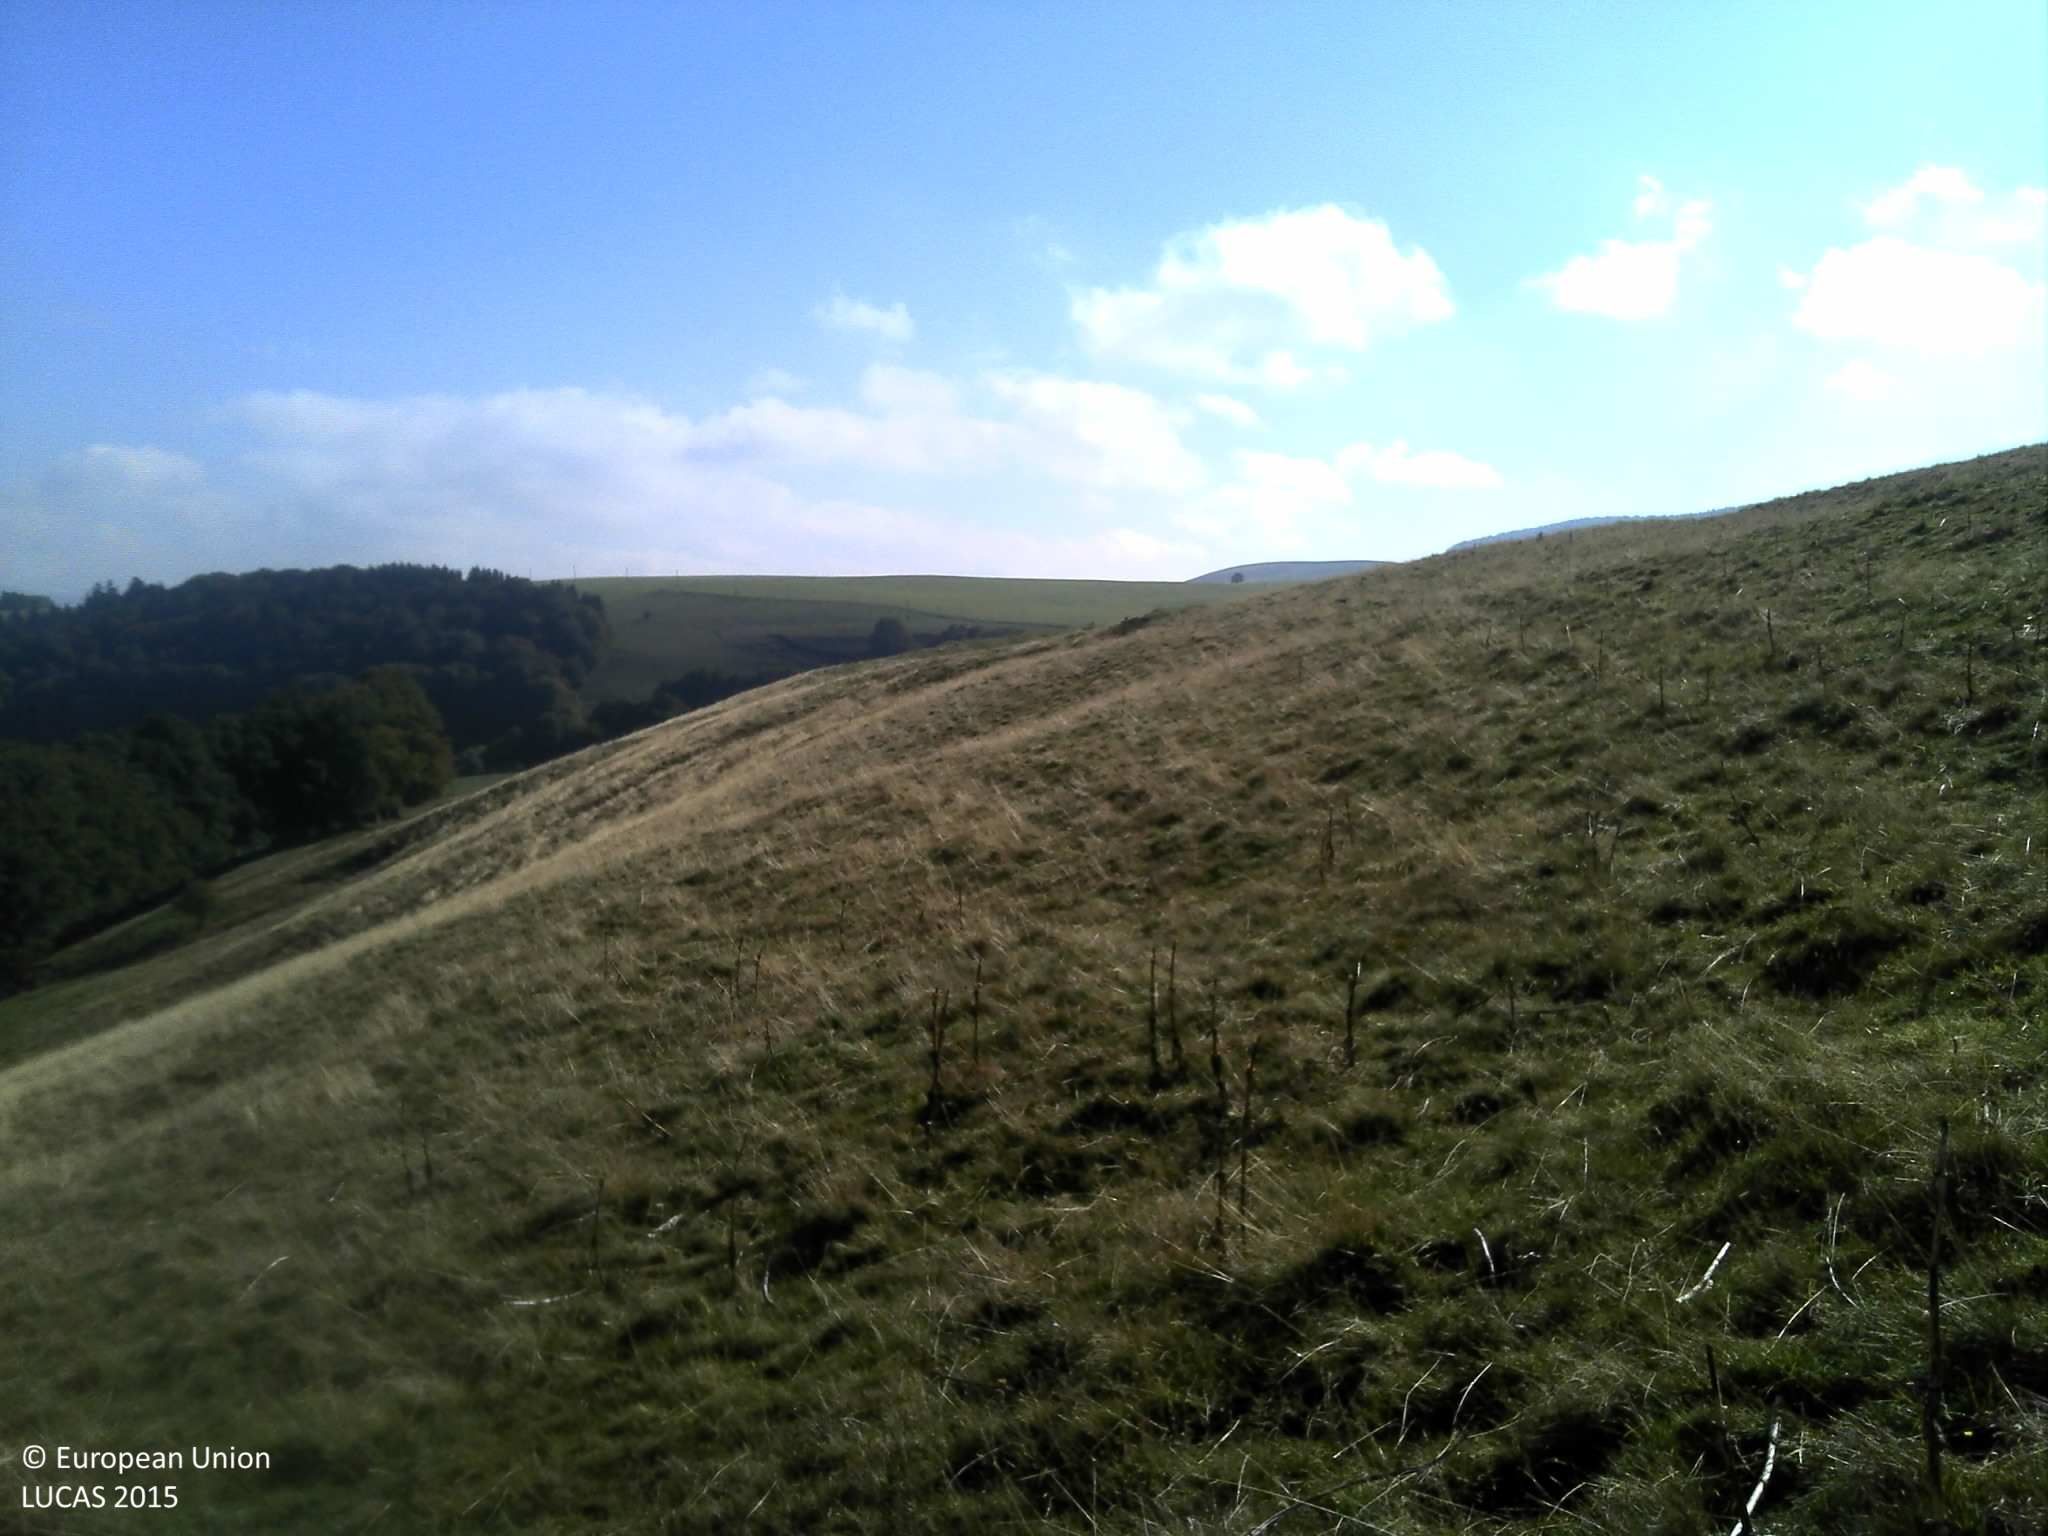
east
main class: Grassland
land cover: Grassland without tree/shrub cover
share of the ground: > 75 %
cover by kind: herbaceous plants 100 %
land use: Agriculture (excluding fallow land and kitchen gardens)
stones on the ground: < 10 %
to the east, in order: Grassland without tree/shrub cover
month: October
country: FR
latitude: 45.4284
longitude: 2.9066
